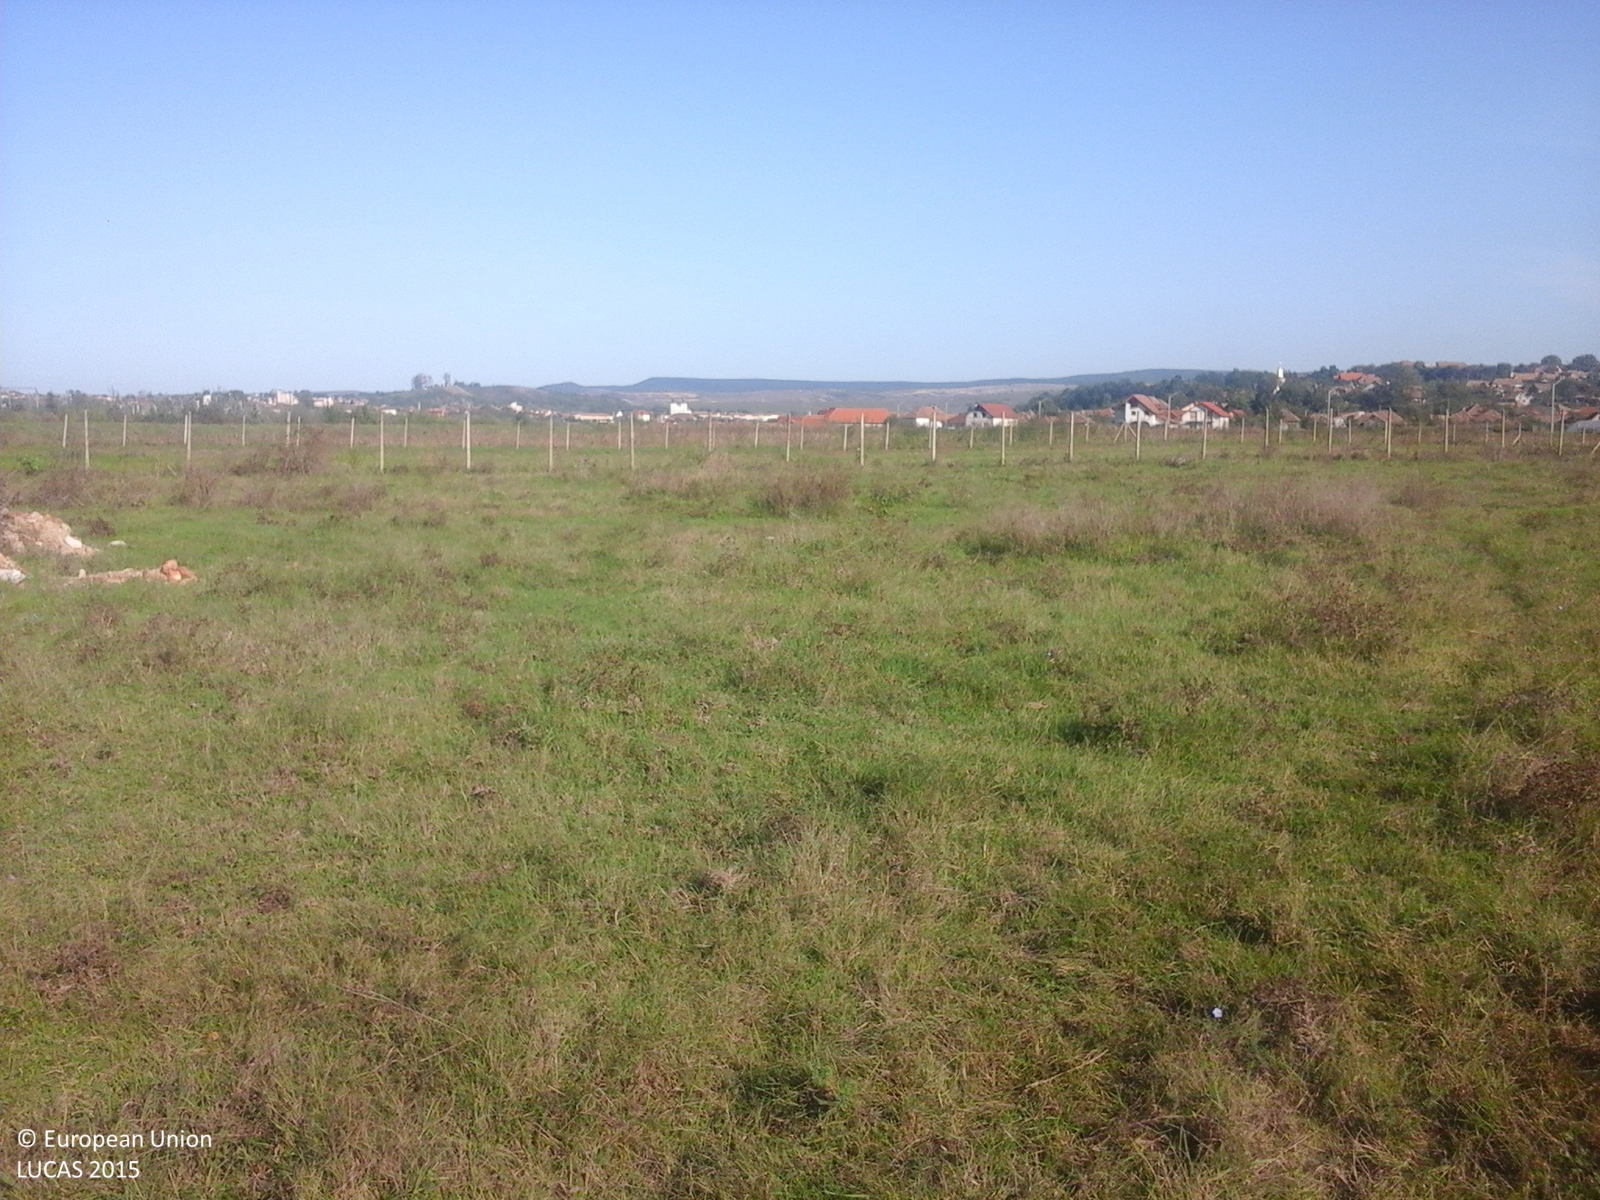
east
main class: Grassland
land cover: Grassland without tree/shrub cover
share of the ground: > 75 %
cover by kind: herbaceous plants 100 %
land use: Agriculture (excluding fallow land and kitchen gardens)
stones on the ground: < 10 %
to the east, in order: Grassland without tree/shrub cover; Fences; Lucerne; Fences; Sunflower; Maize
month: October
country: RO
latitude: 46.1699
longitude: 23.8926
